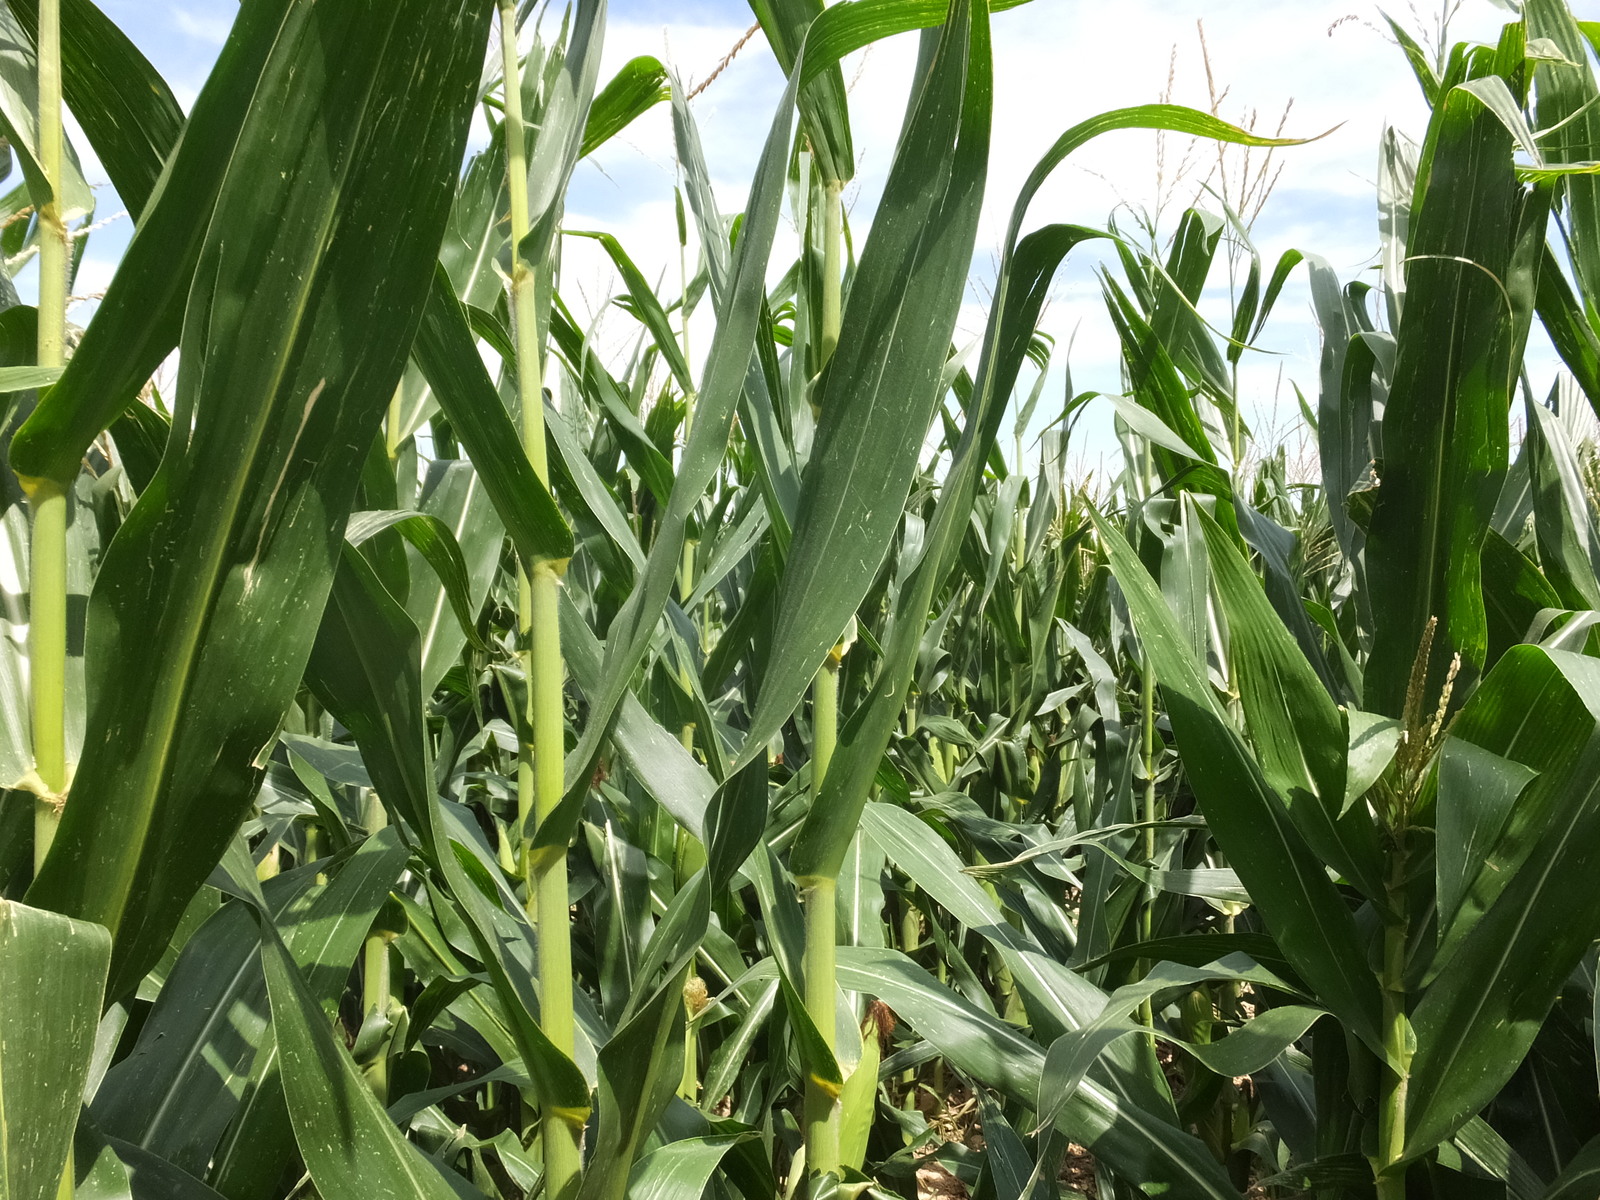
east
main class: Cropland
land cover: Maize
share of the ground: > 75 %
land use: Agriculture (excluding fallow land and kitchen gardens)
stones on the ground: < 10 %
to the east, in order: Maize; Shruby margins; Tracks; Artificial constructions; Paved roads, cycling and walking lanes; Artificial constructions; Shrubland without tree cover; Tracks; Shrubland without tree cover
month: August
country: ES
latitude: 41.5132
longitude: 0.1008
